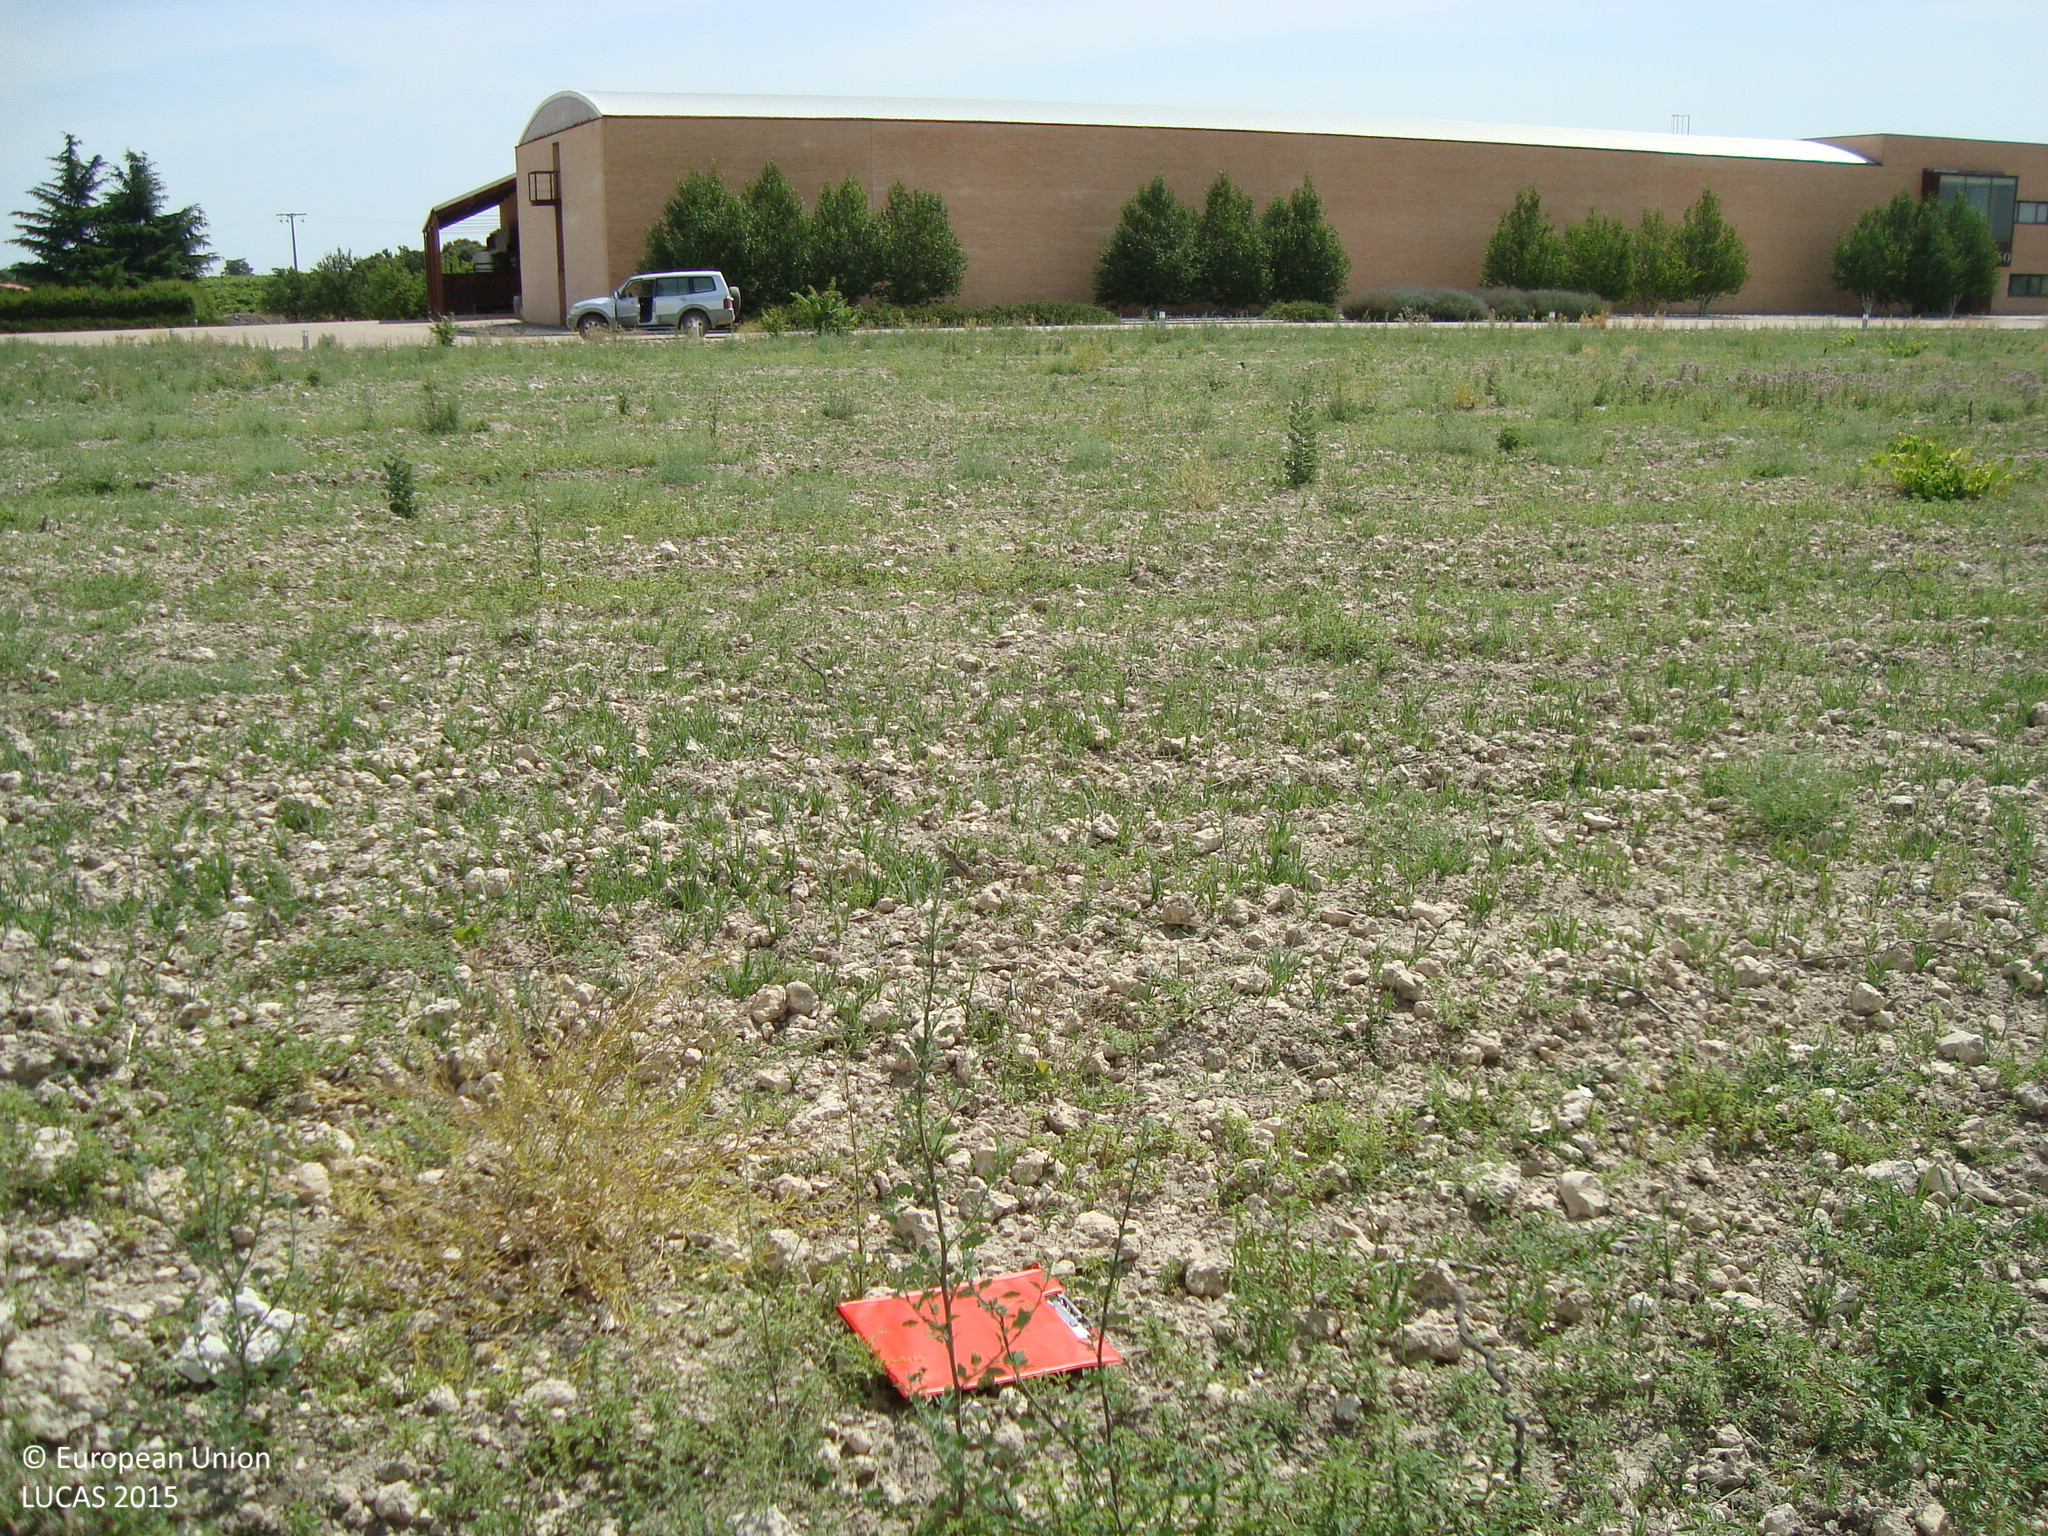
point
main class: Grassland
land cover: Spontaneously vegetated surfaces
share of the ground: 25 - 50 %
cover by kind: unconsolidated bare surface 60 %, herbaceous plants 40 %
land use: Abandoned areas
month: July
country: ES
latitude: 41.7265
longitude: -4.1618
